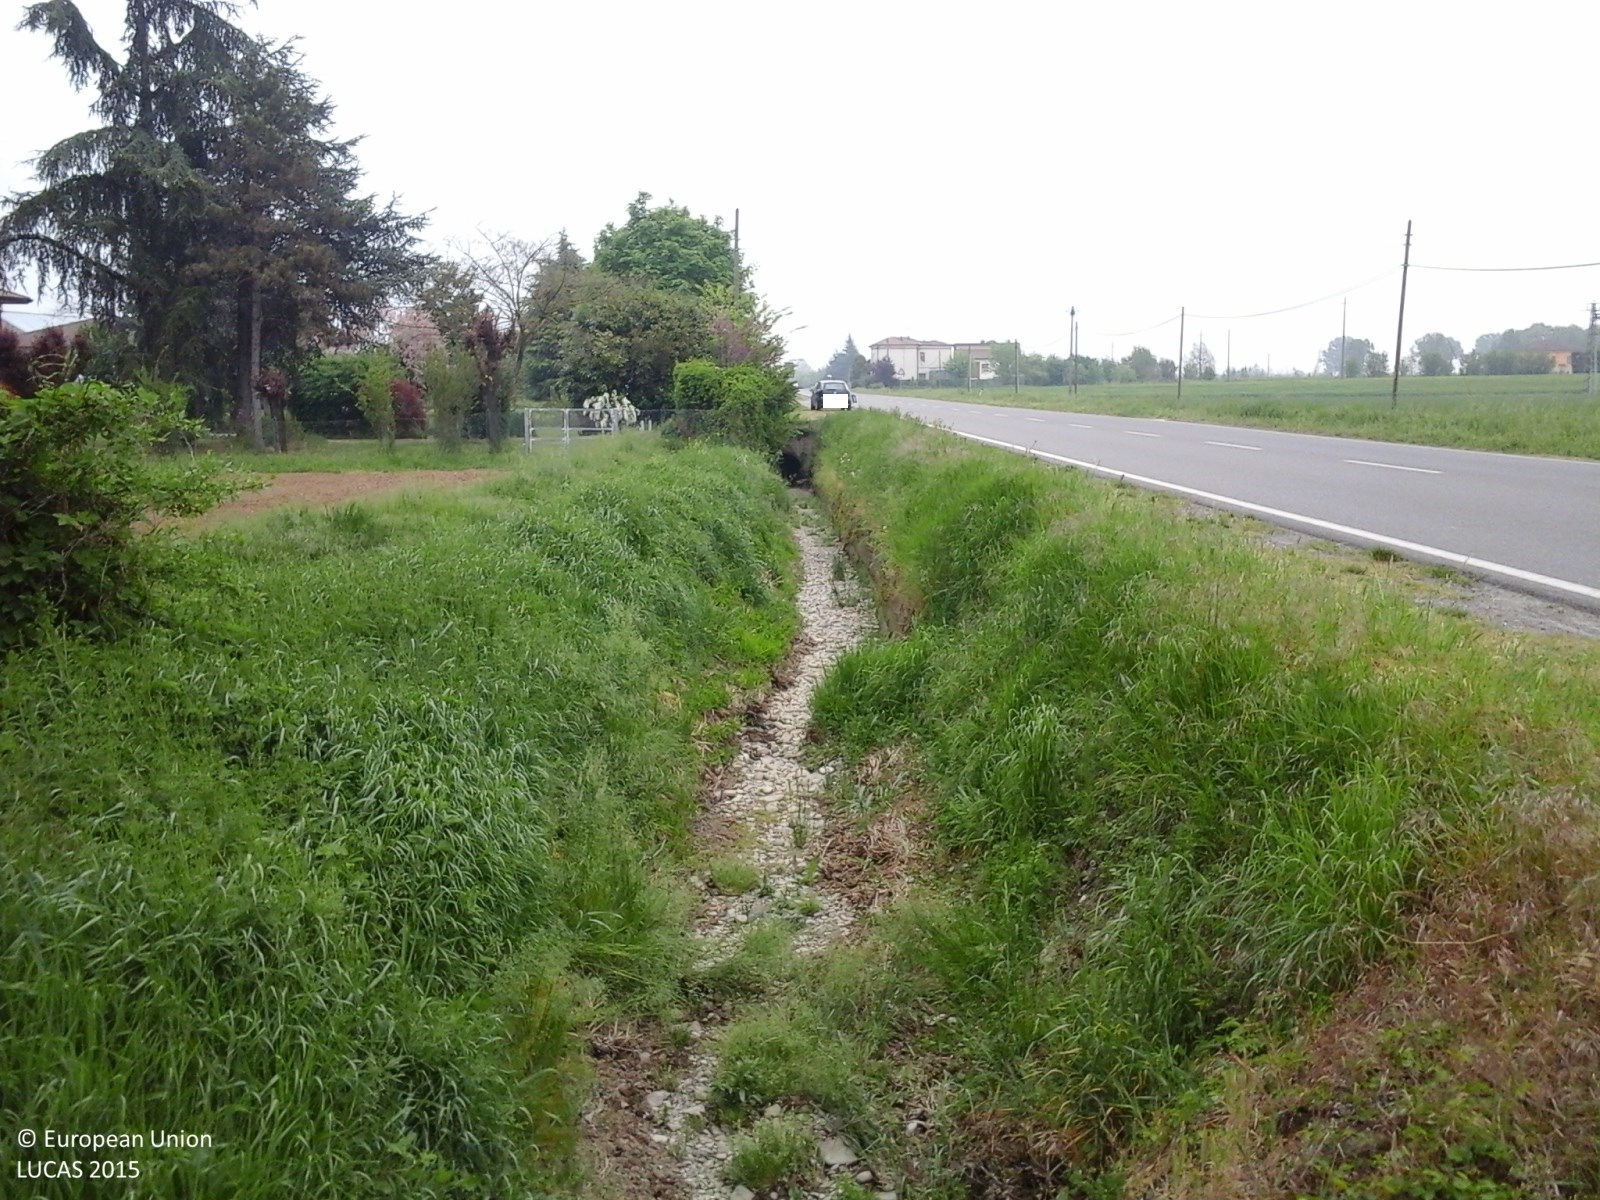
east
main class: Cropland
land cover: Other fresh vegetables
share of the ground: < 10 %
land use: Kitchen garden
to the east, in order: Grass margins; Fences; Grassland with sparse tree/shrub cover; Tracks; Managed hedges; Fences; Lucerne; Artificial constructions in urban areas; Lucerne; Artificial constructions in urban areas; Temporary grasslands; Electric lines; Temporary grasslands
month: April
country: IT
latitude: 45.0163
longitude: 9.4554
